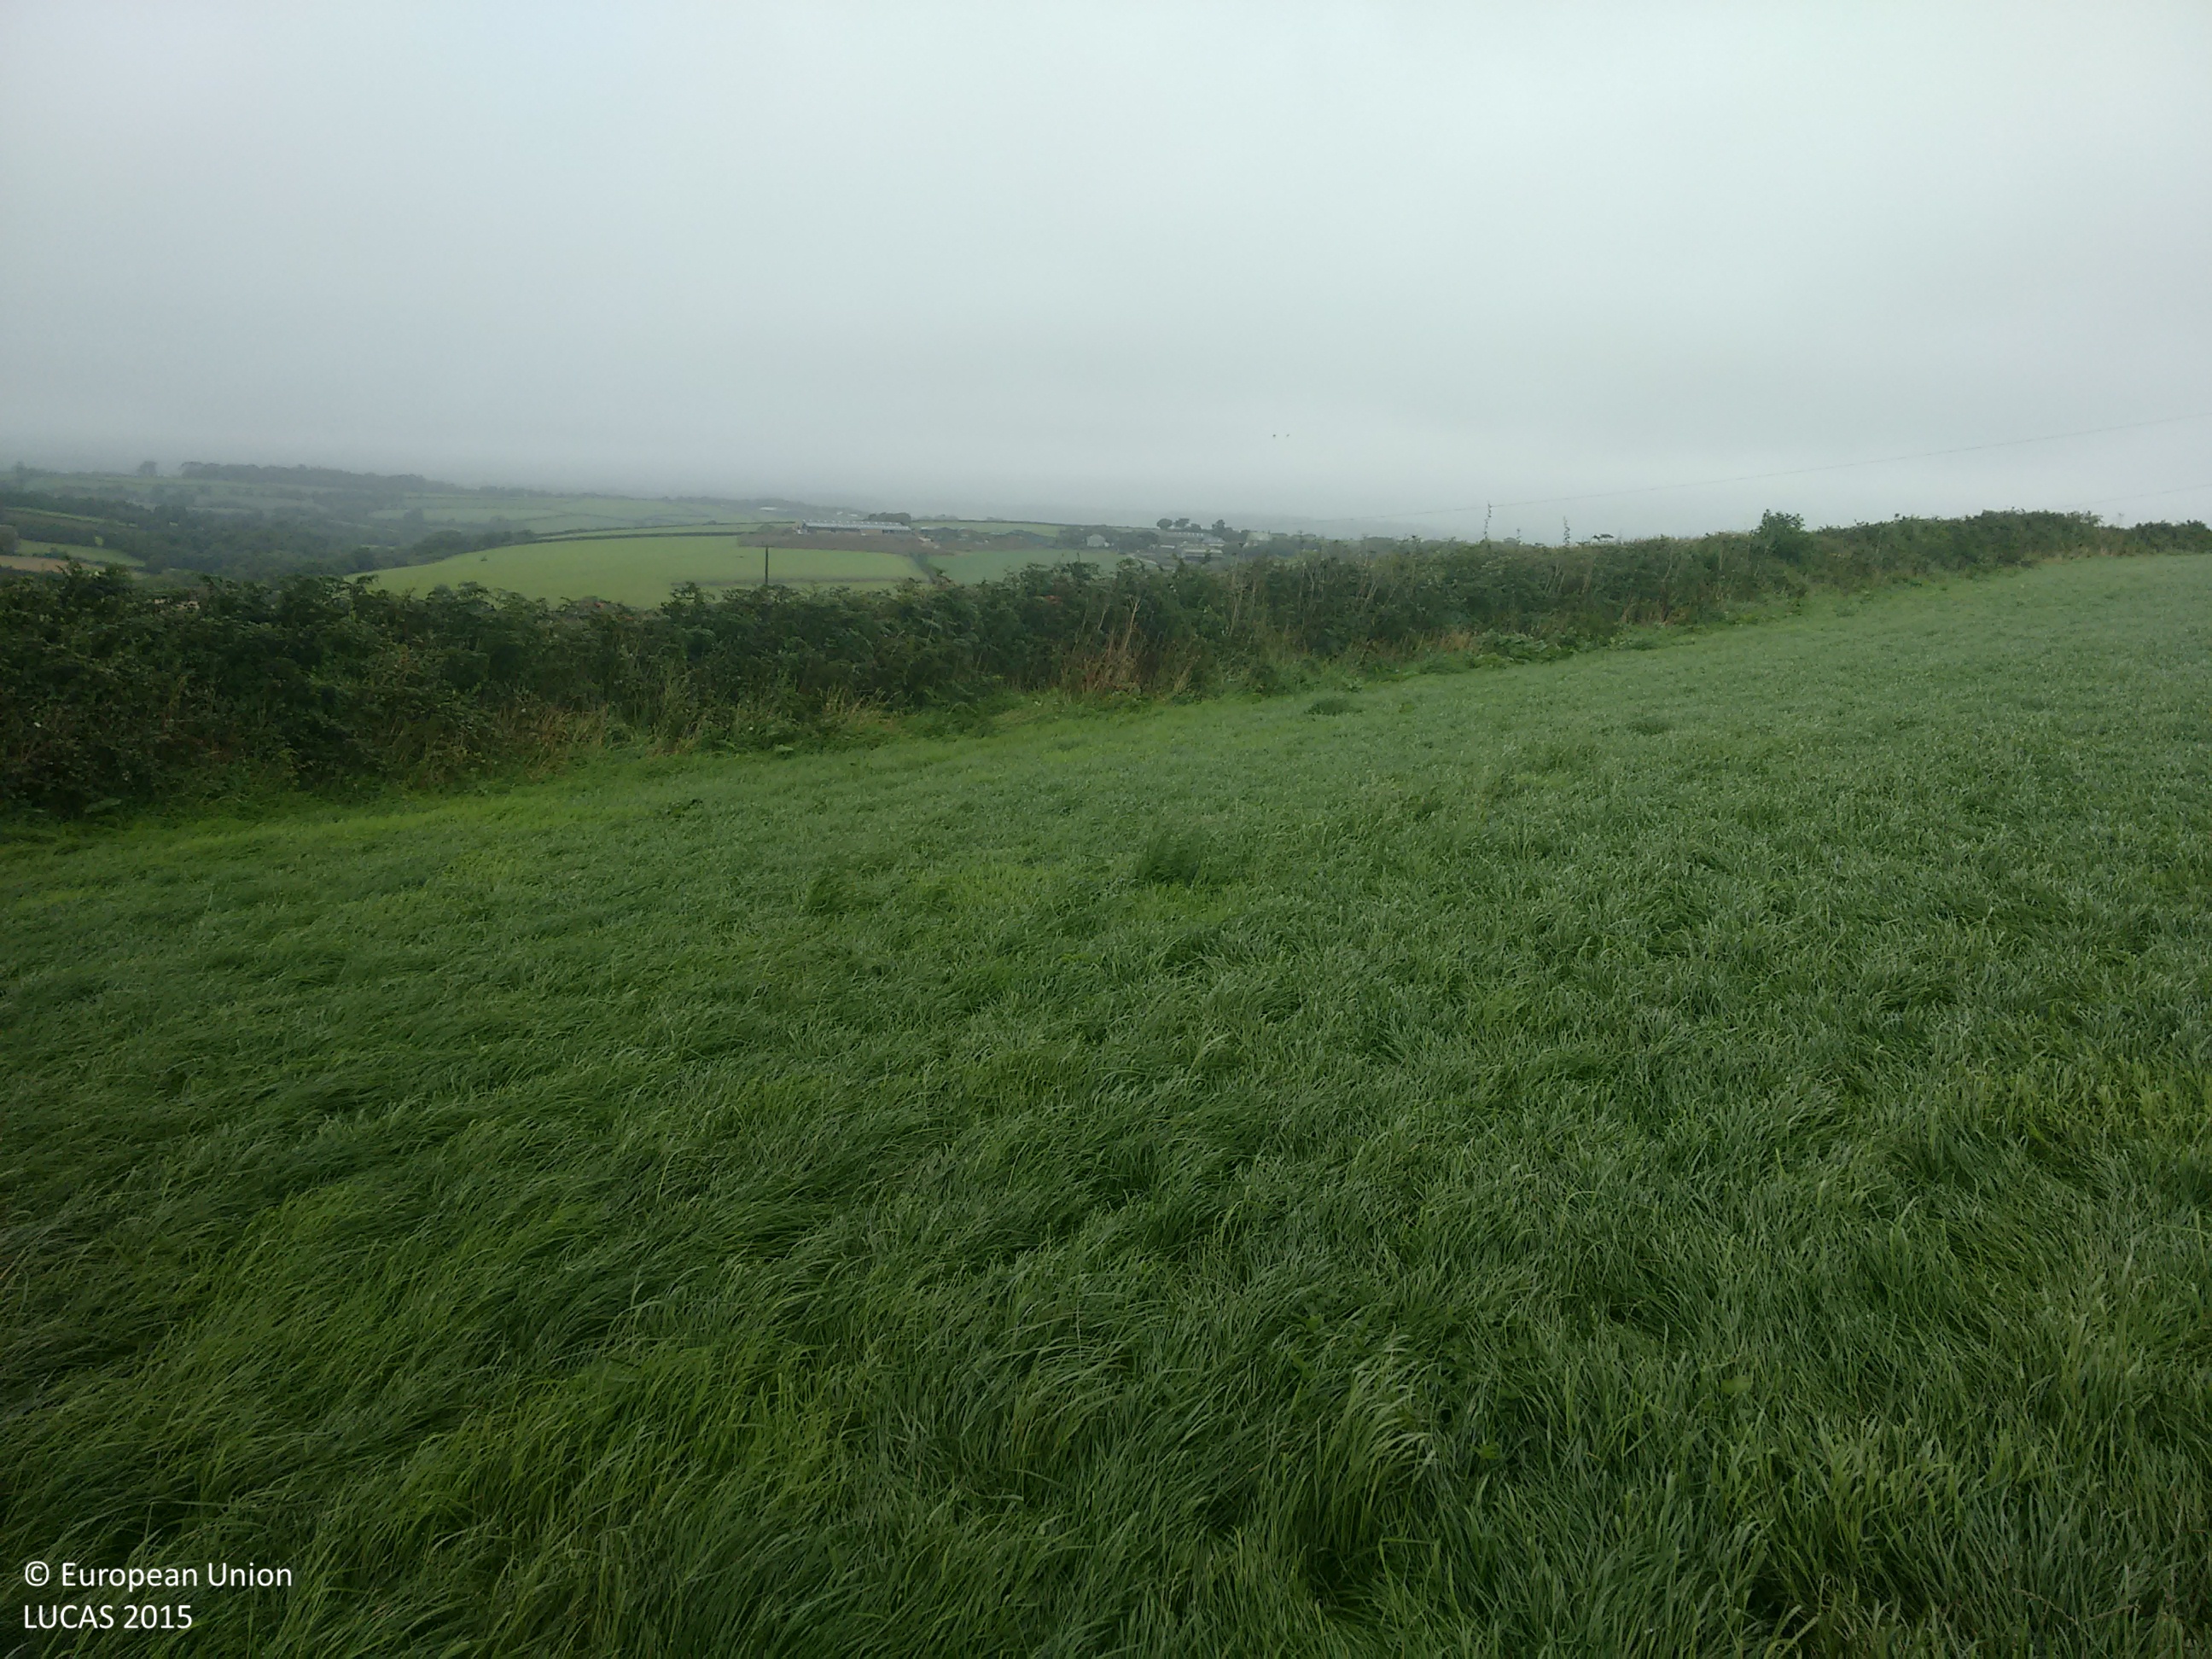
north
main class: Grassland
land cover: Grassland without tree/shrub cover
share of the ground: > 75 %
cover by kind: herbaceous plants 100 %
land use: Agriculture (excluding fallow land and kitchen gardens)
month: August
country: GB
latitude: 50.0665
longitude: -5.1080
